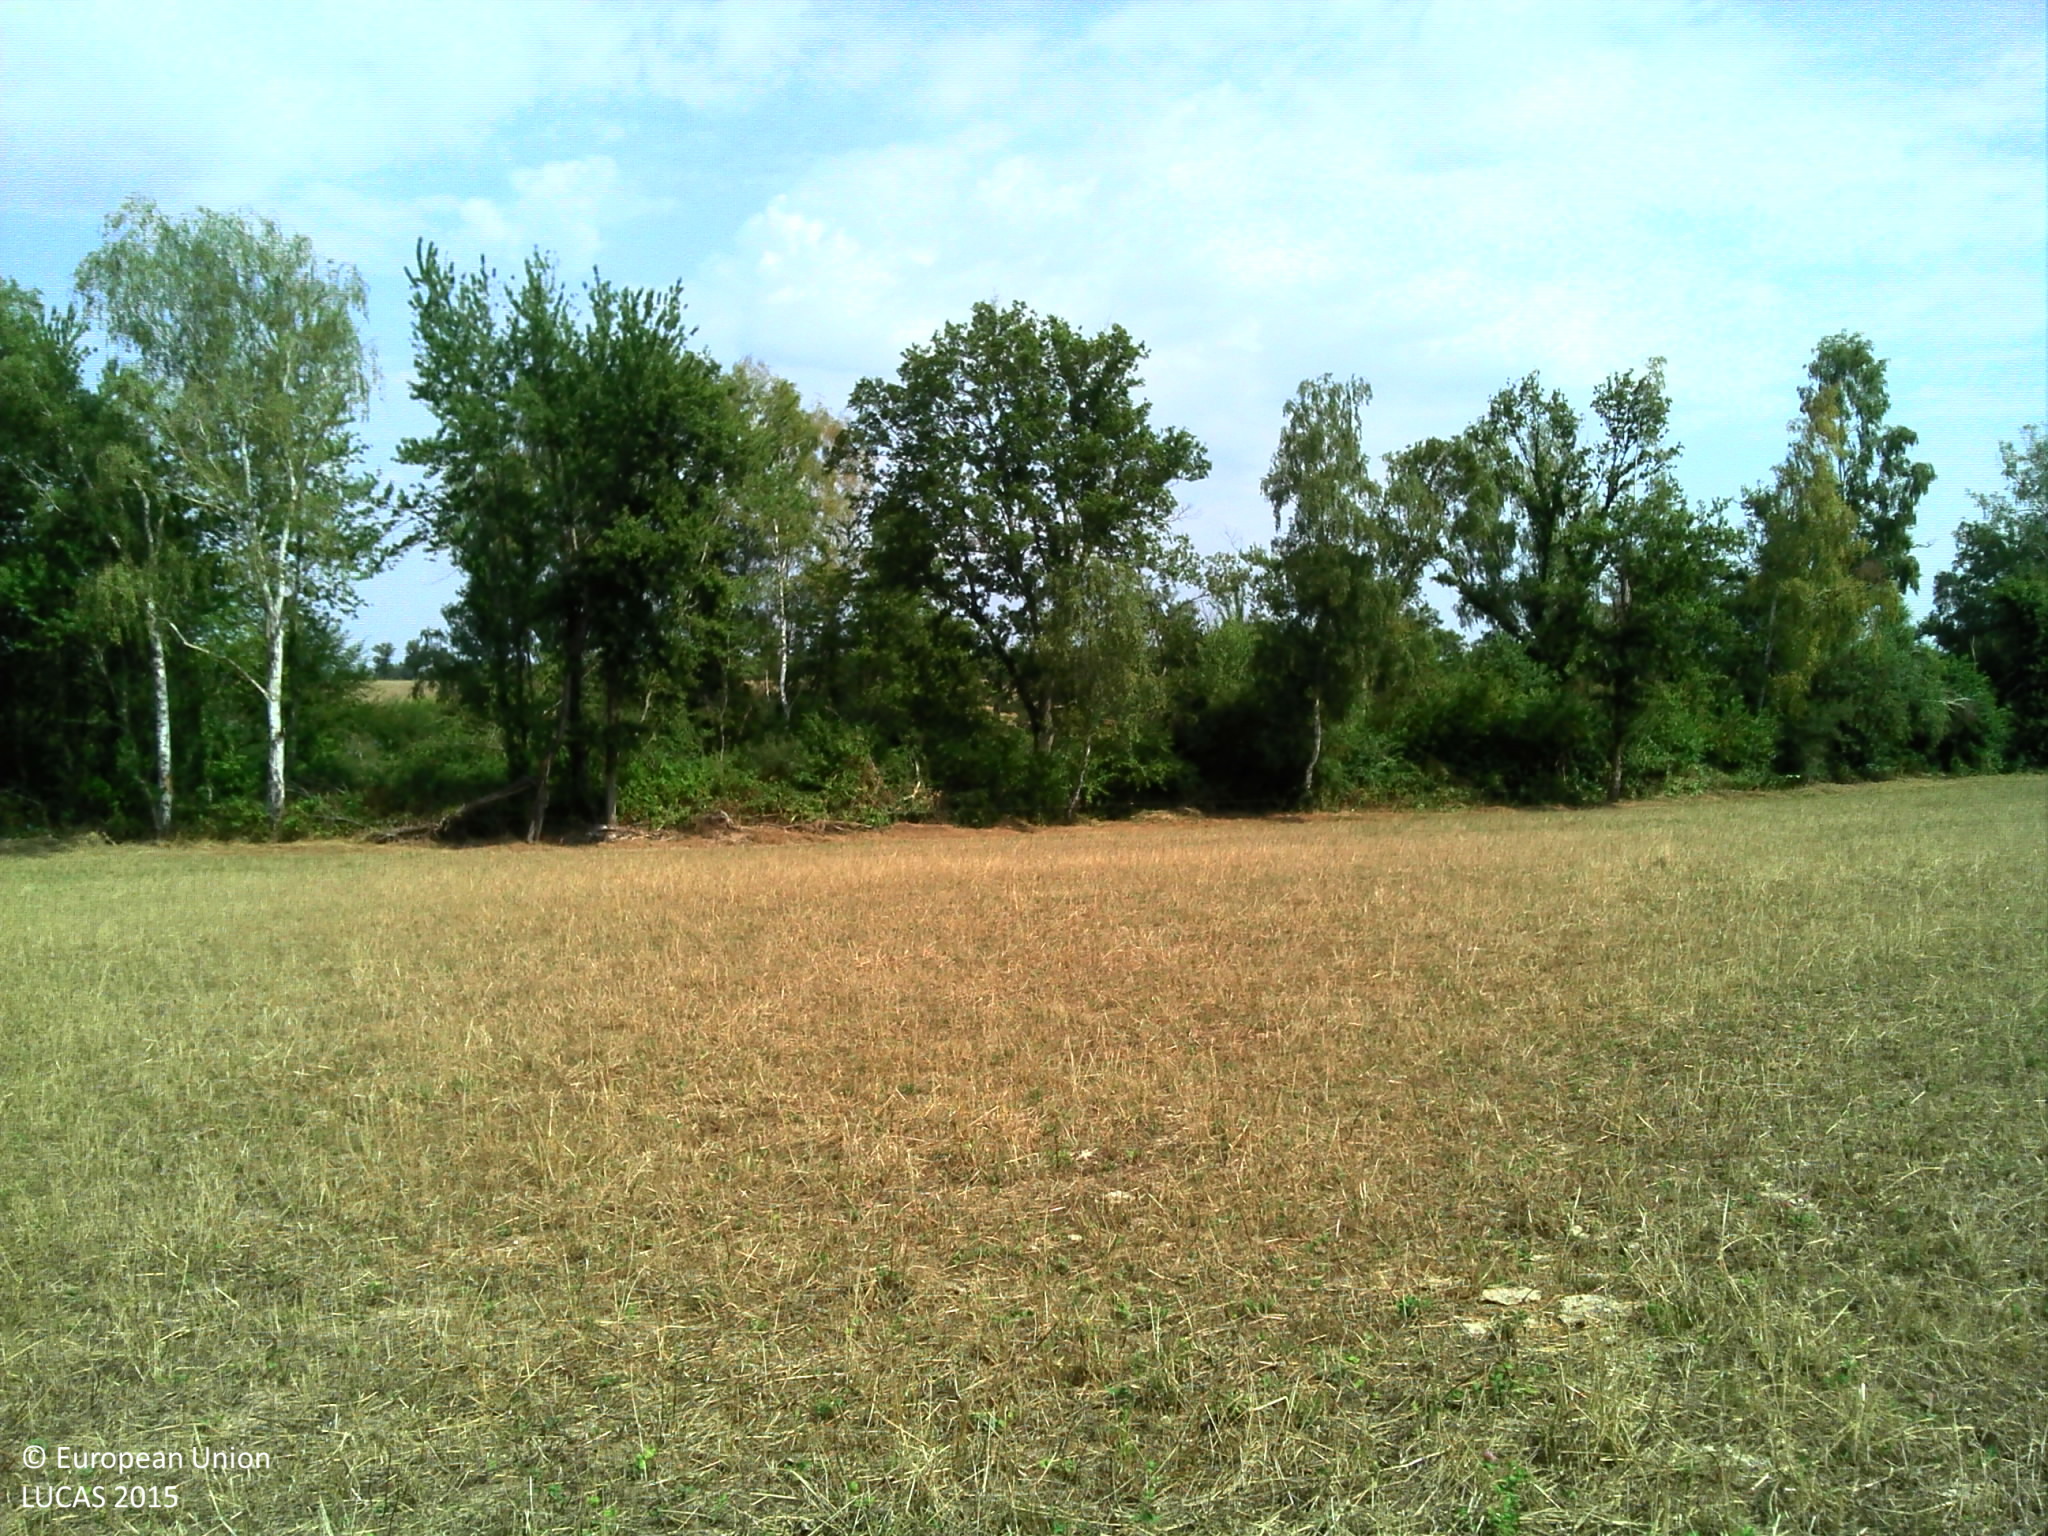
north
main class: Cropland
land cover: Temporary grasslands
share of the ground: > 75 %
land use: Agriculture (excluding fallow land and kitchen gardens)
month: August
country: FR
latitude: 46.6967
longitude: 2.9476
